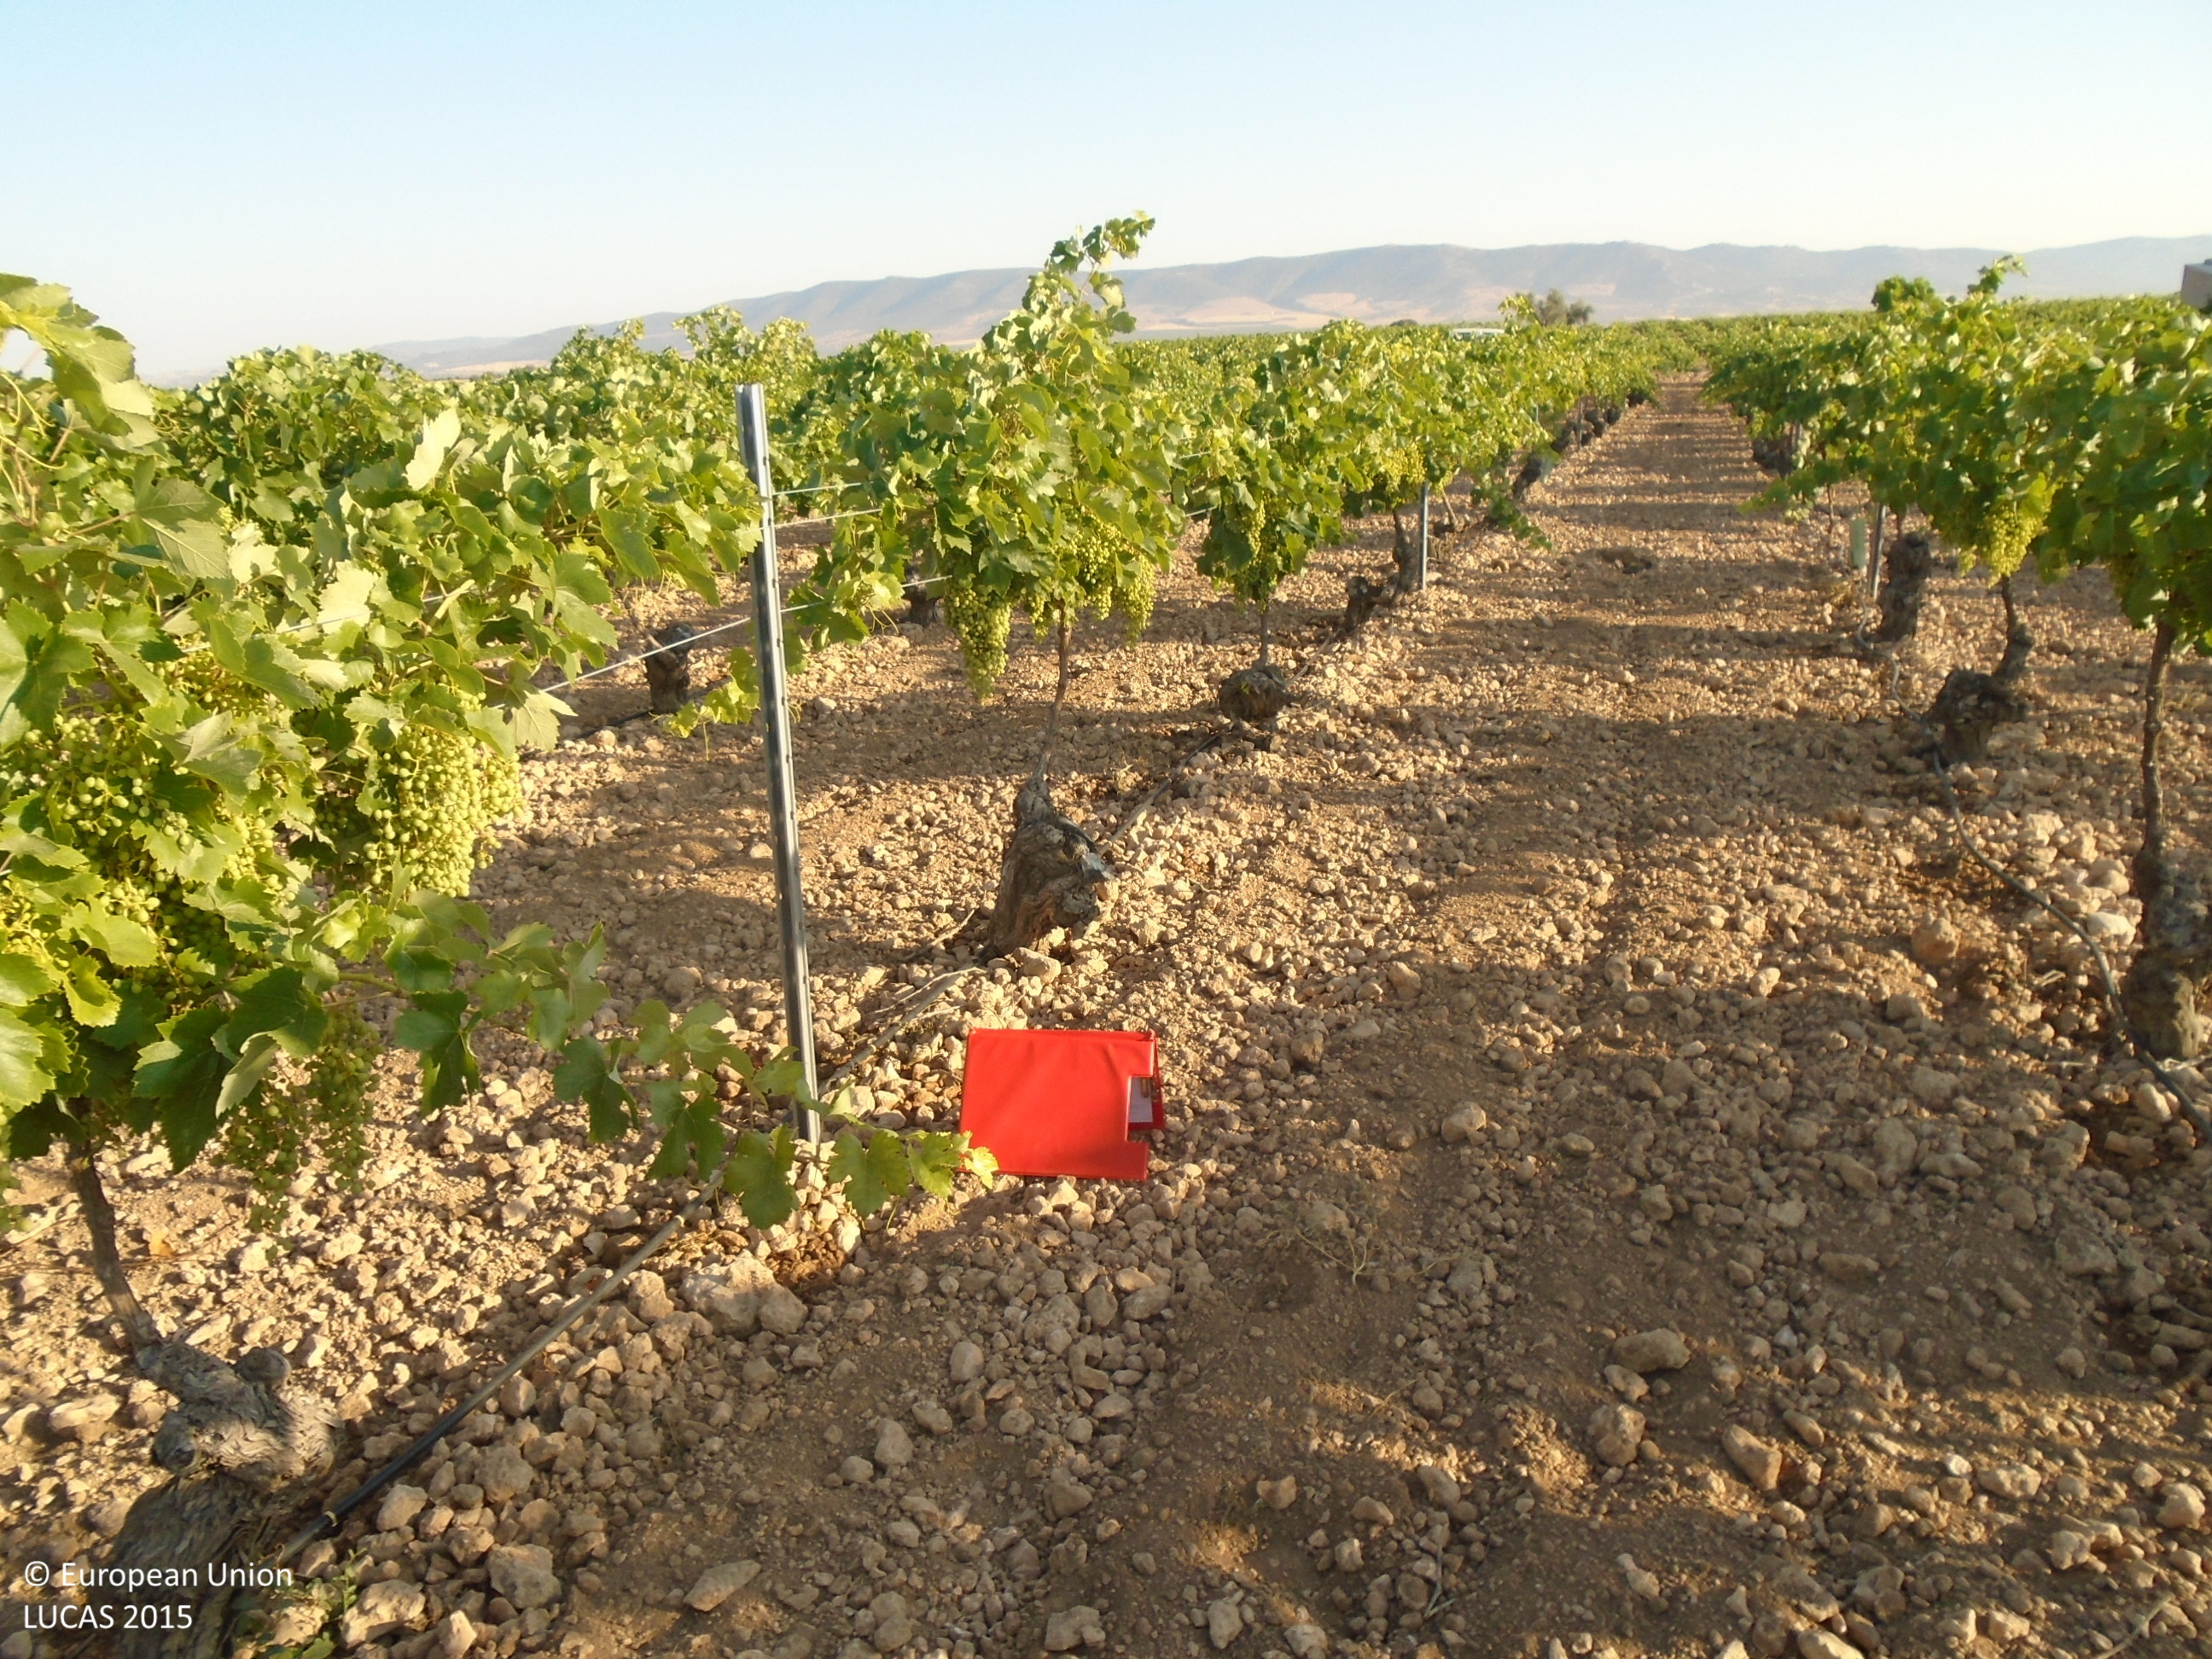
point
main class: Cropland
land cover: Vineyards
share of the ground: 10 - 25 %
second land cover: Other bare soil
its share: > 75 %
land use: Agriculture (excluding fallow land and kitchen gardens)
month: June
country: ES
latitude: 39.1484
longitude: -3.6149
